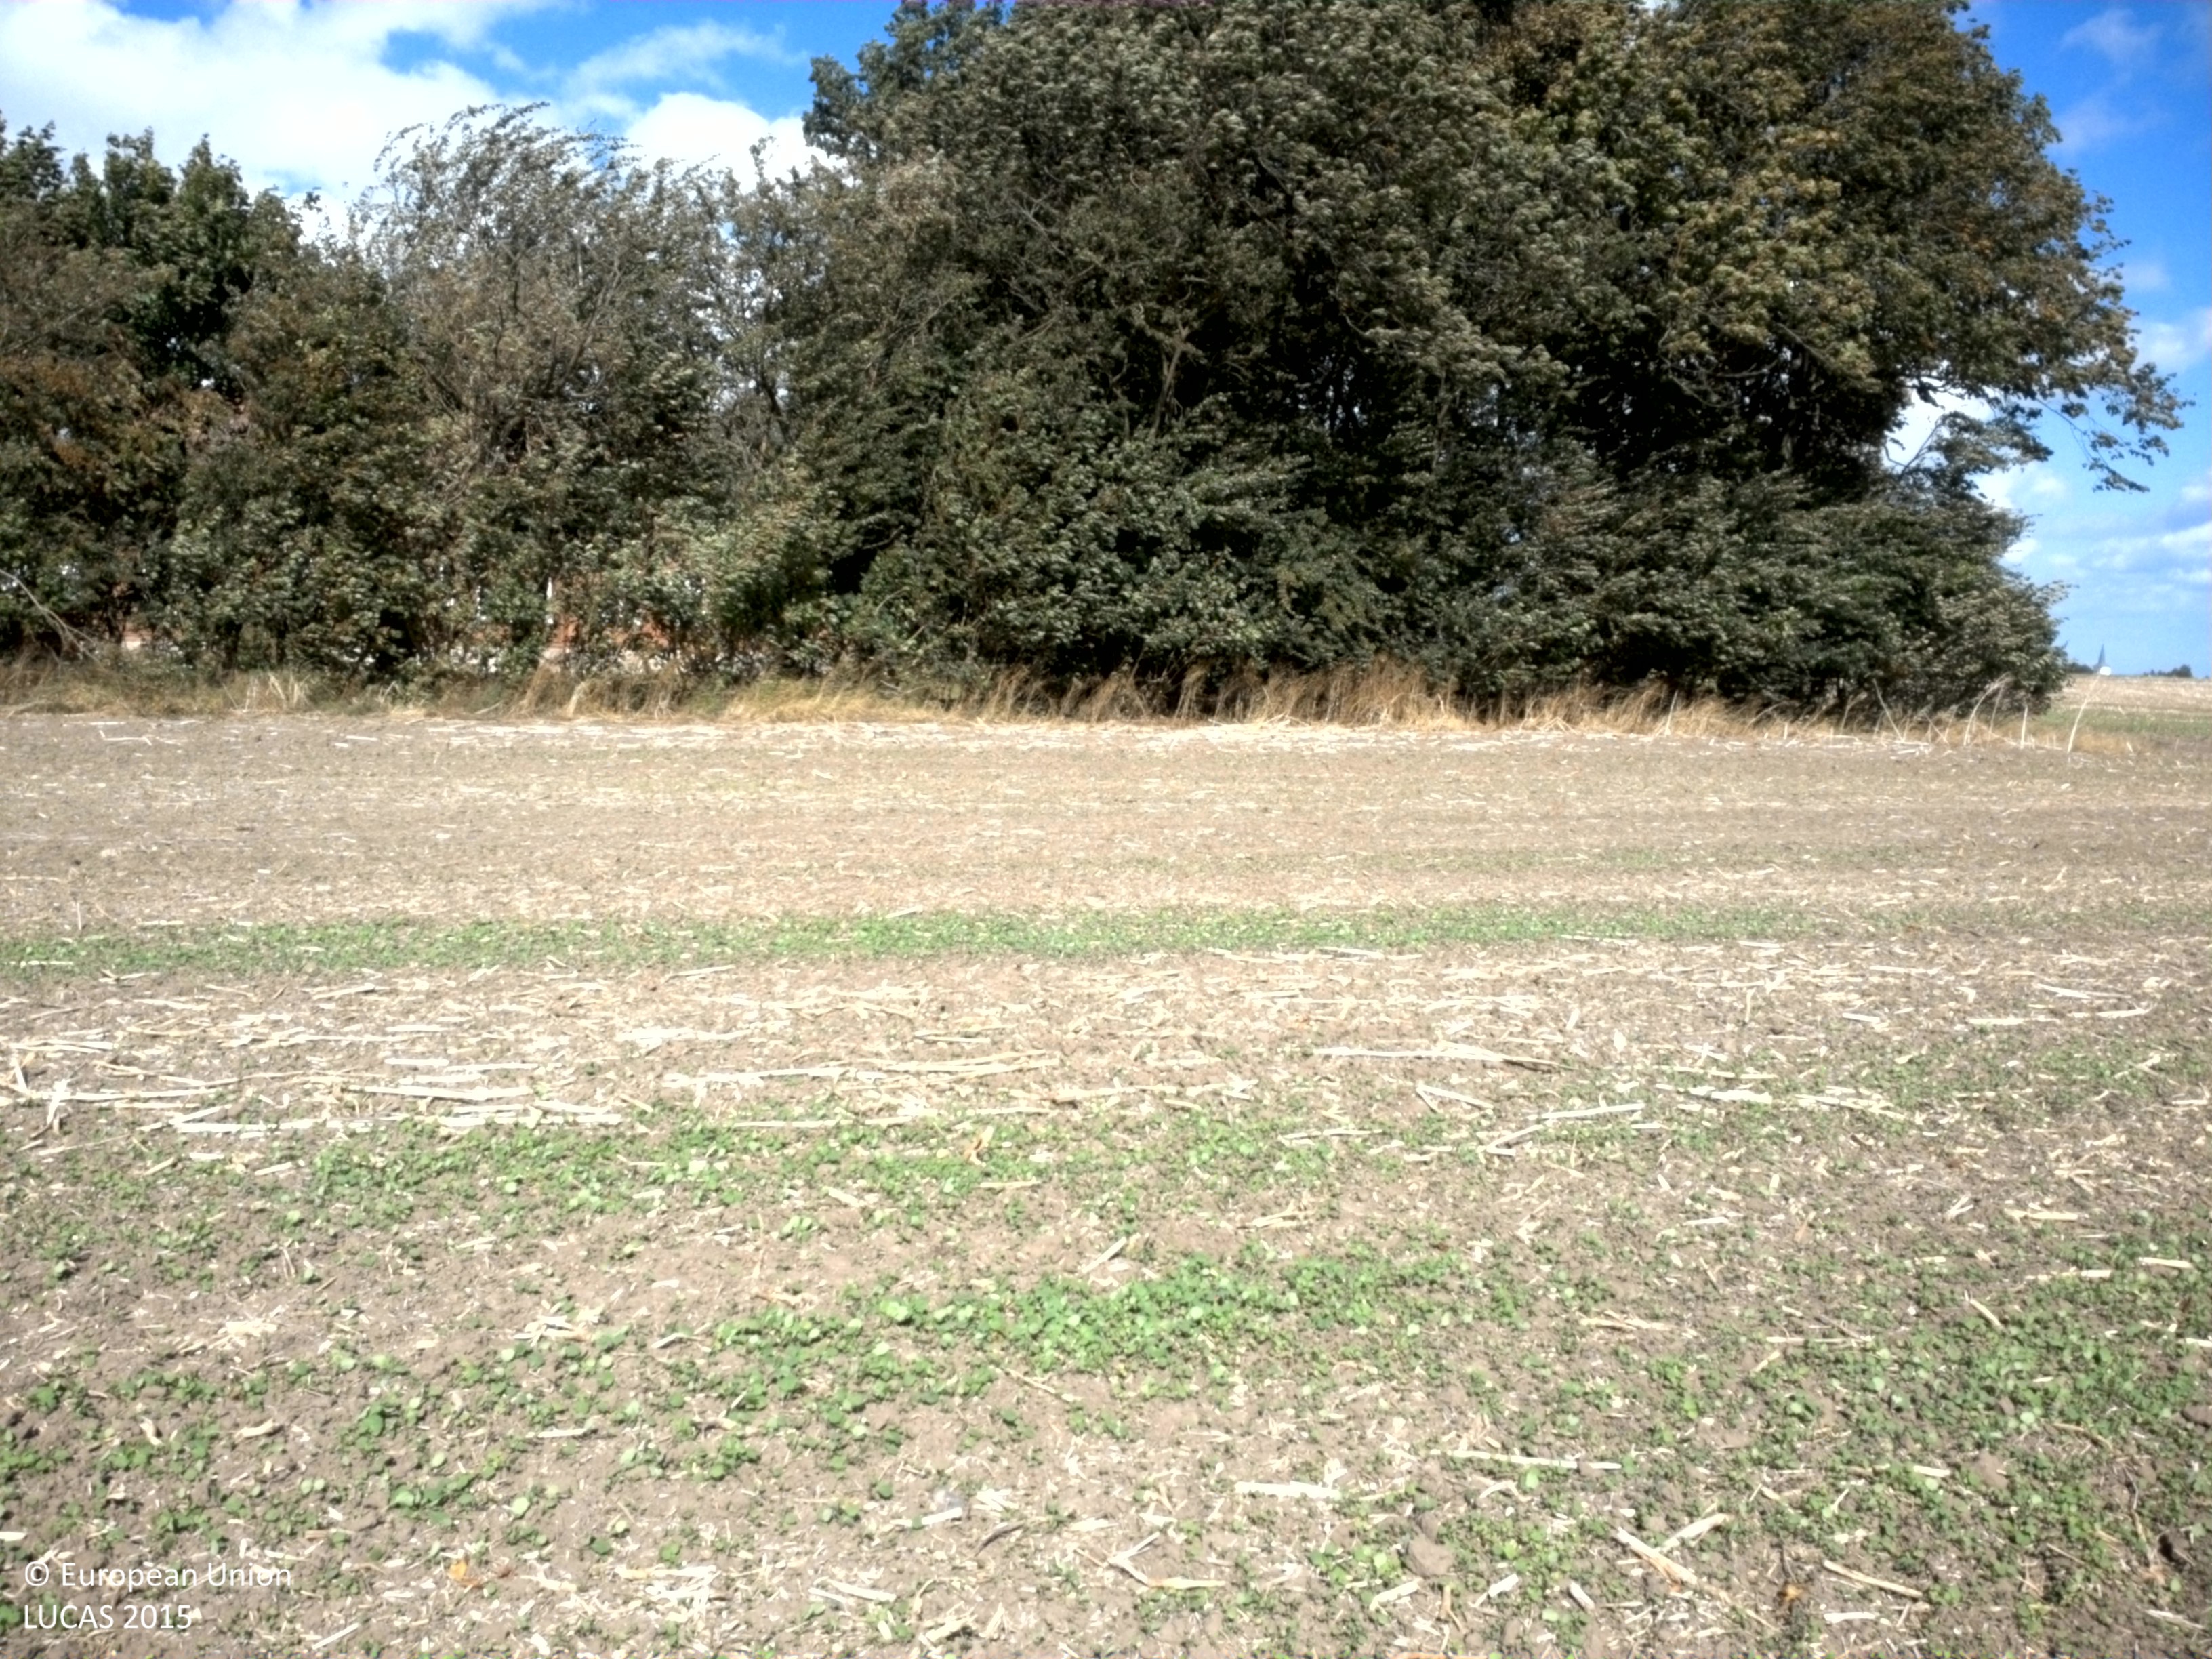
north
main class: Cropland
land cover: Rape and turnip rape
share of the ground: < 10 %
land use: Agriculture (excluding fallow land and kitchen gardens)
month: September
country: SE
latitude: 55.4893
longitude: 14.1927
